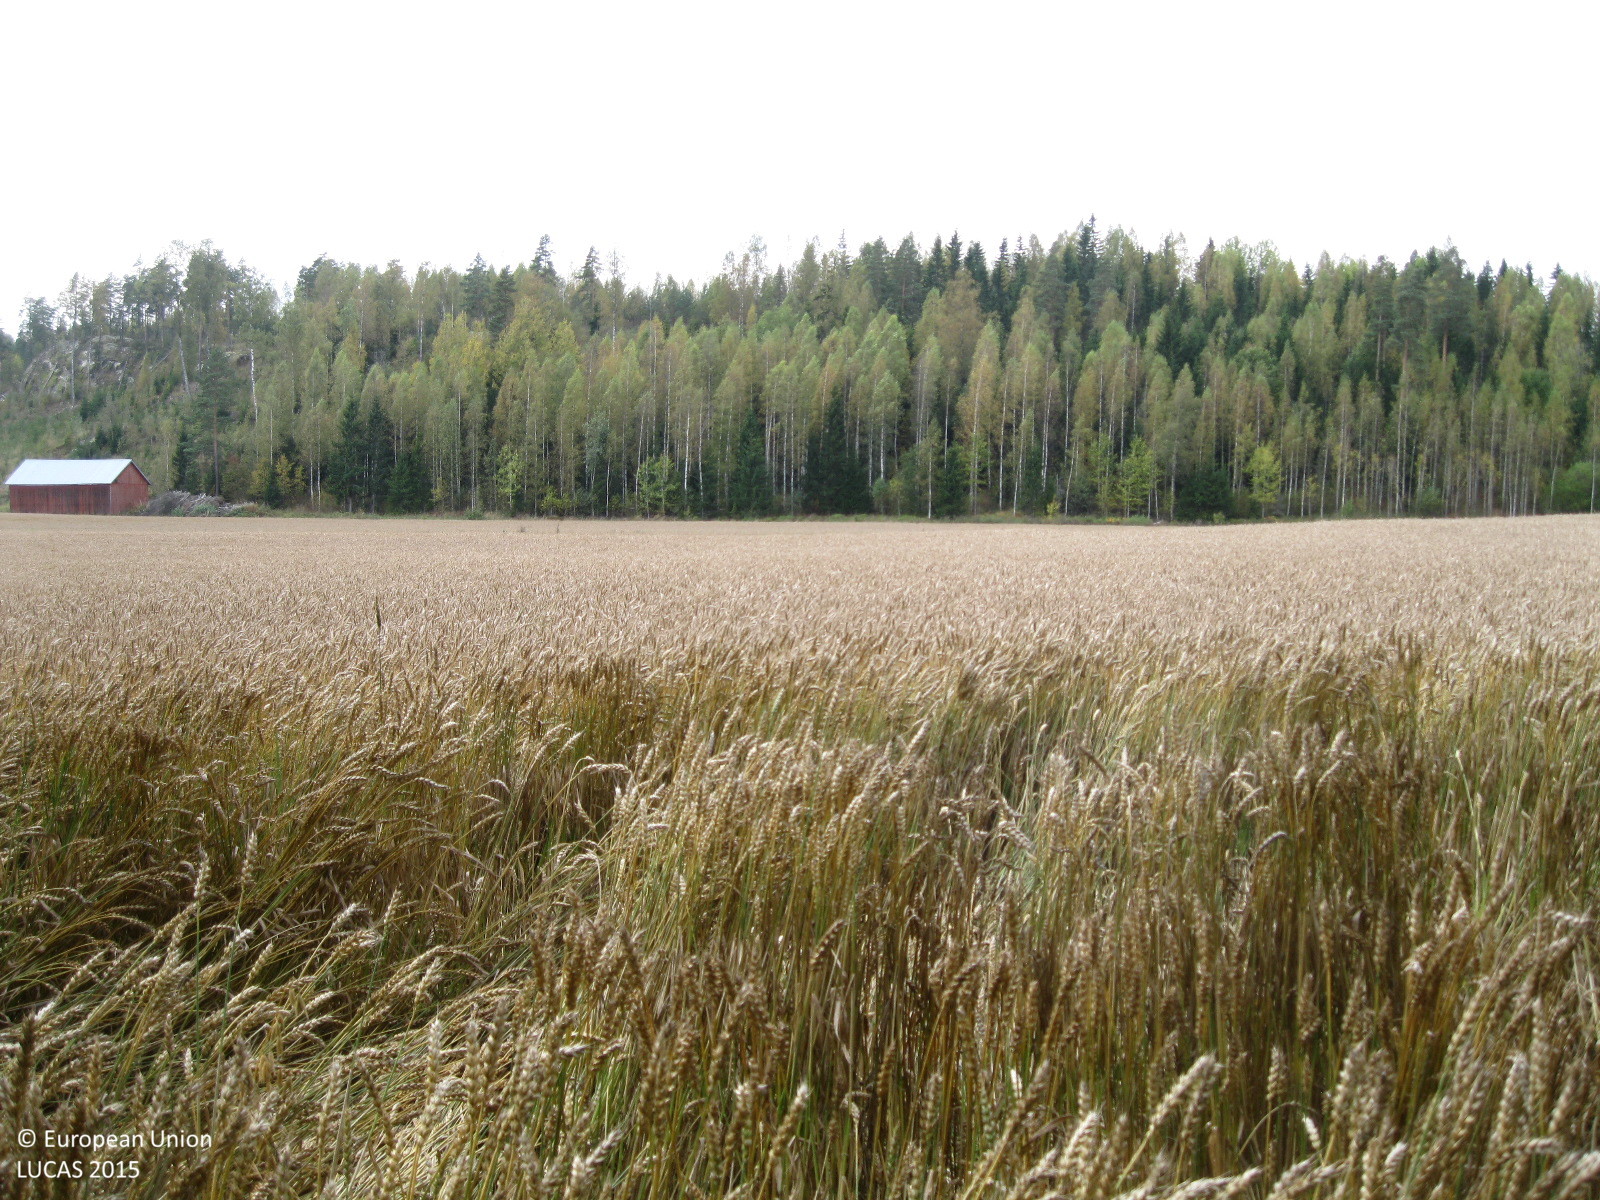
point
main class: Cropland
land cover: Common wheat
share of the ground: > 75 %
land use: Agriculture (excluding fallow land and kitchen gardens)
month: September
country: FI
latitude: 60.4171
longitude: 24.1364
